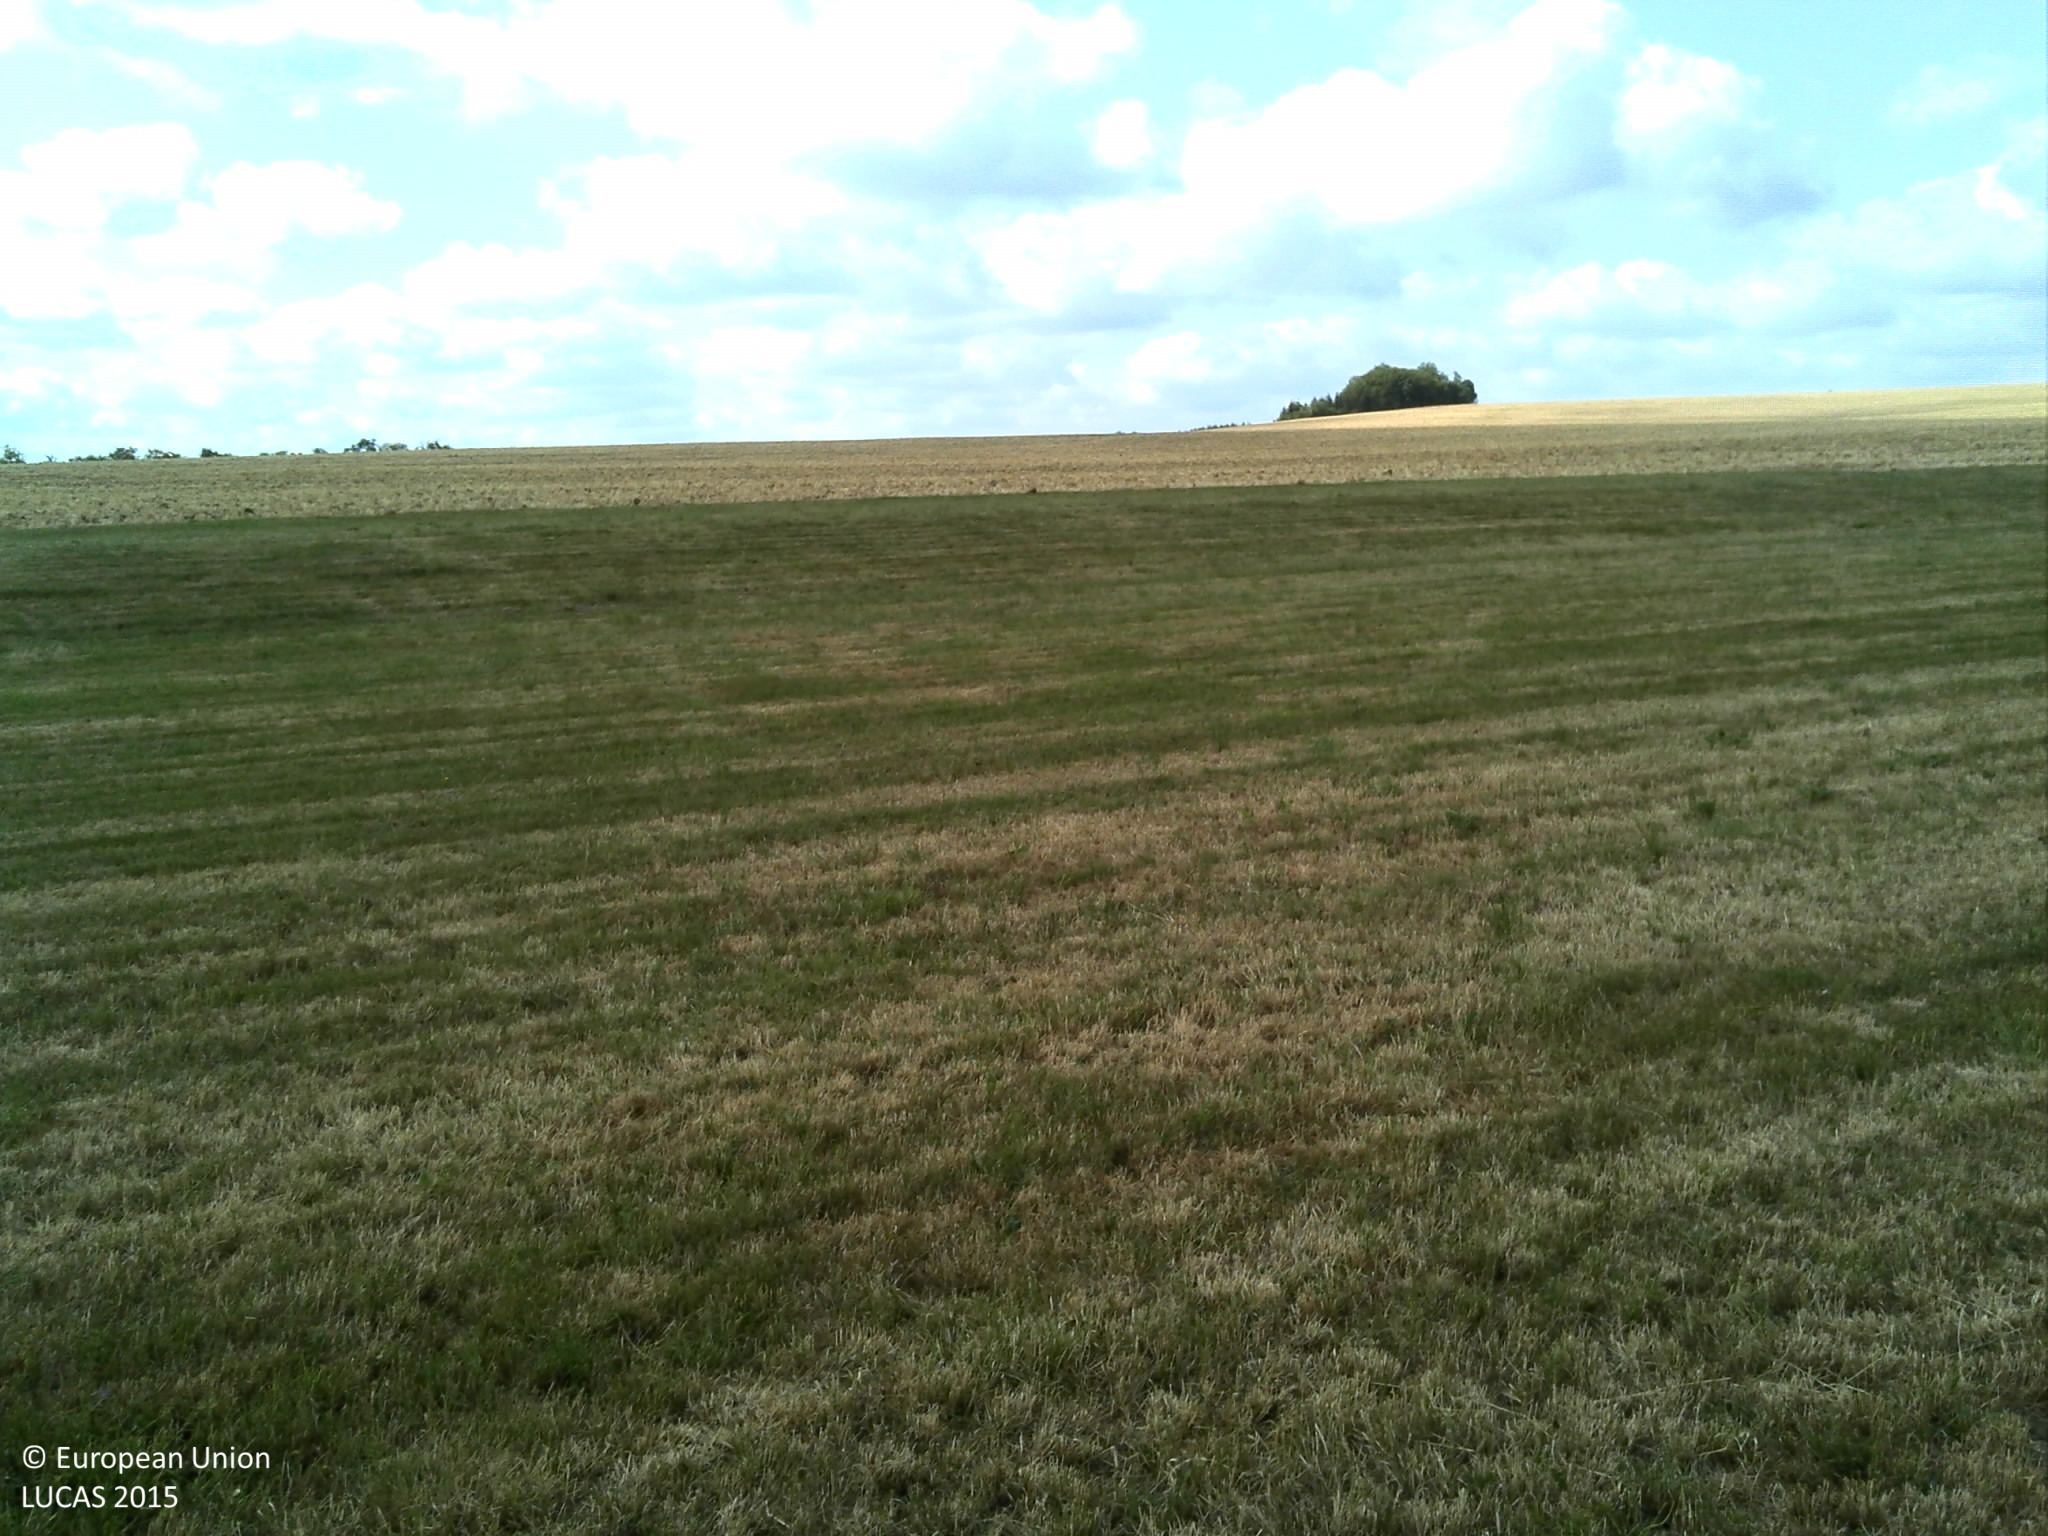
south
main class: Grassland
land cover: Grassland without tree/shrub cover
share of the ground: > 75 %
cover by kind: herbaceous plants 100 %
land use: Agriculture (excluding fallow land and kitchen gardens)
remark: Harvested field
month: July
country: FR
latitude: 48.1759
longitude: 6.1947
